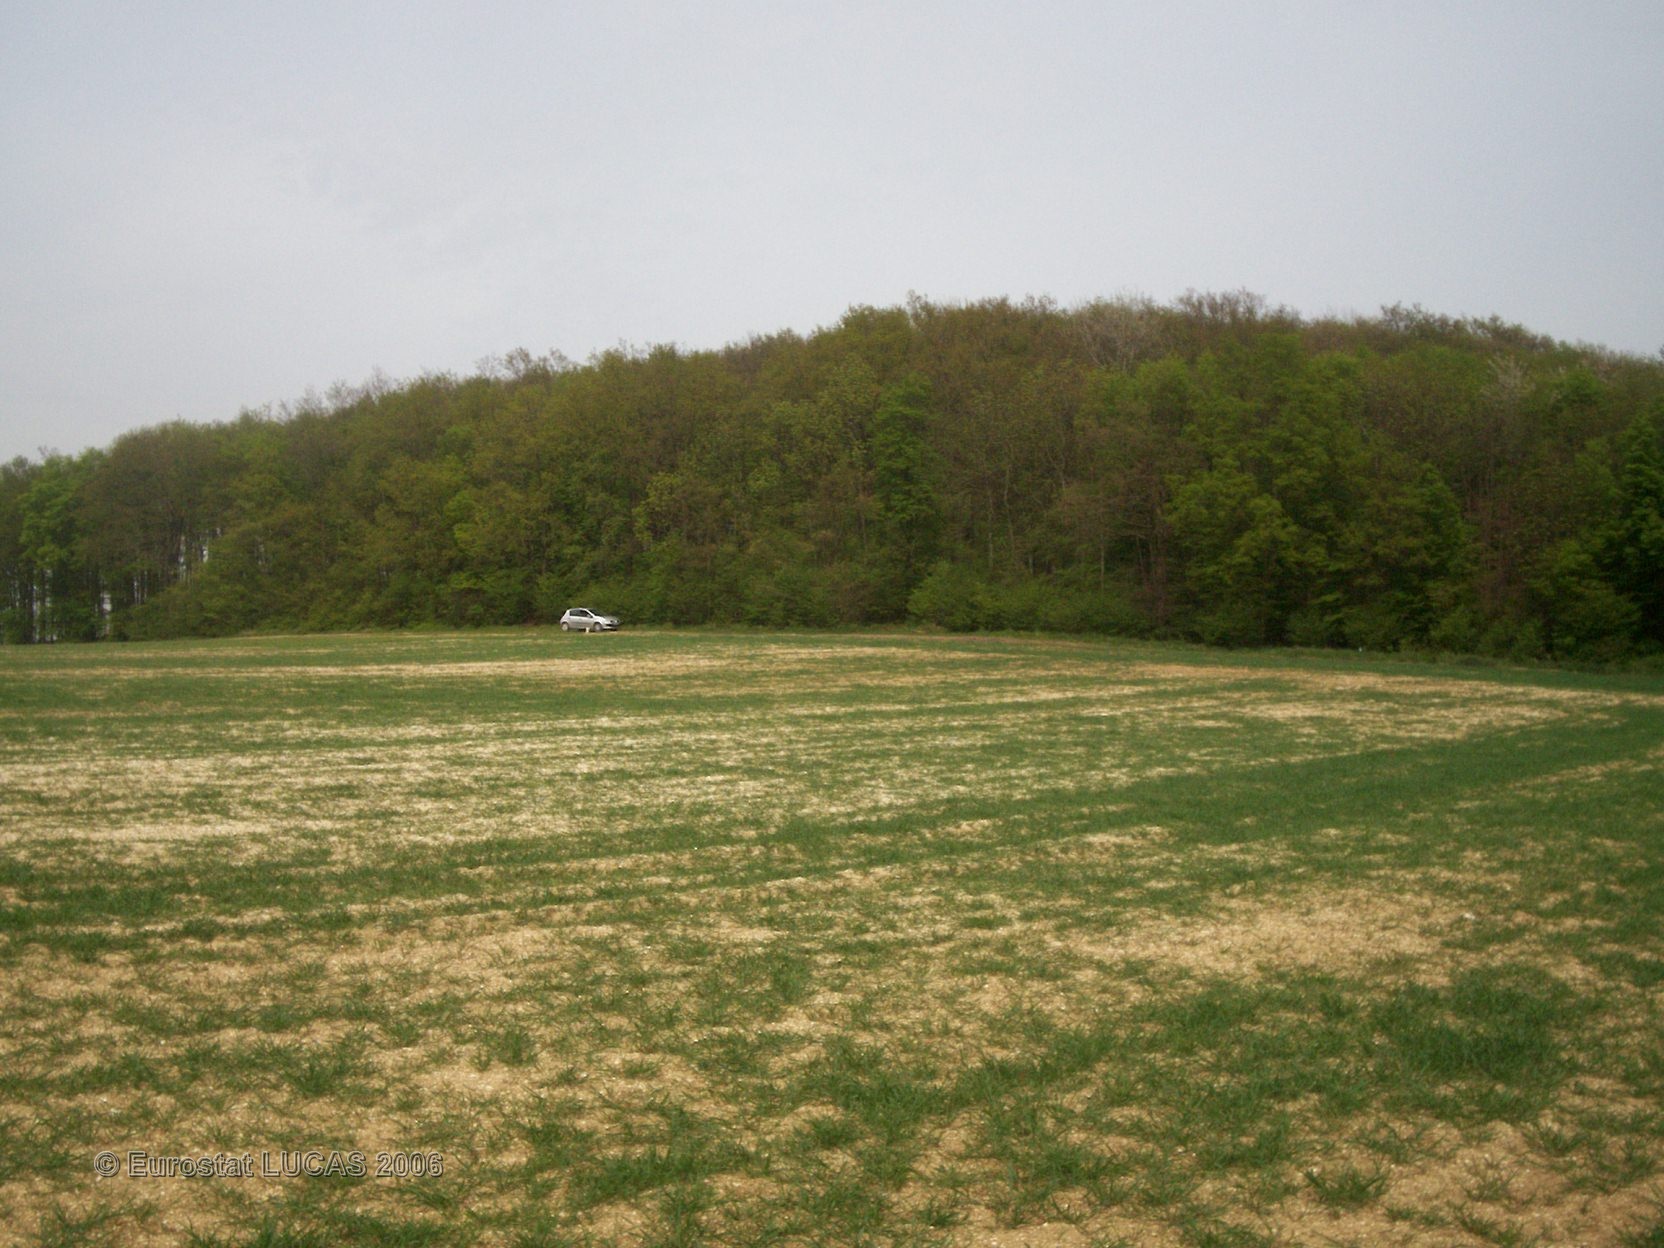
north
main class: Grassland
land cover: Grassland without tree/shrub cover
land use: Fallow land
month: May
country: FR
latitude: 49.6651
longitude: 3.6617
